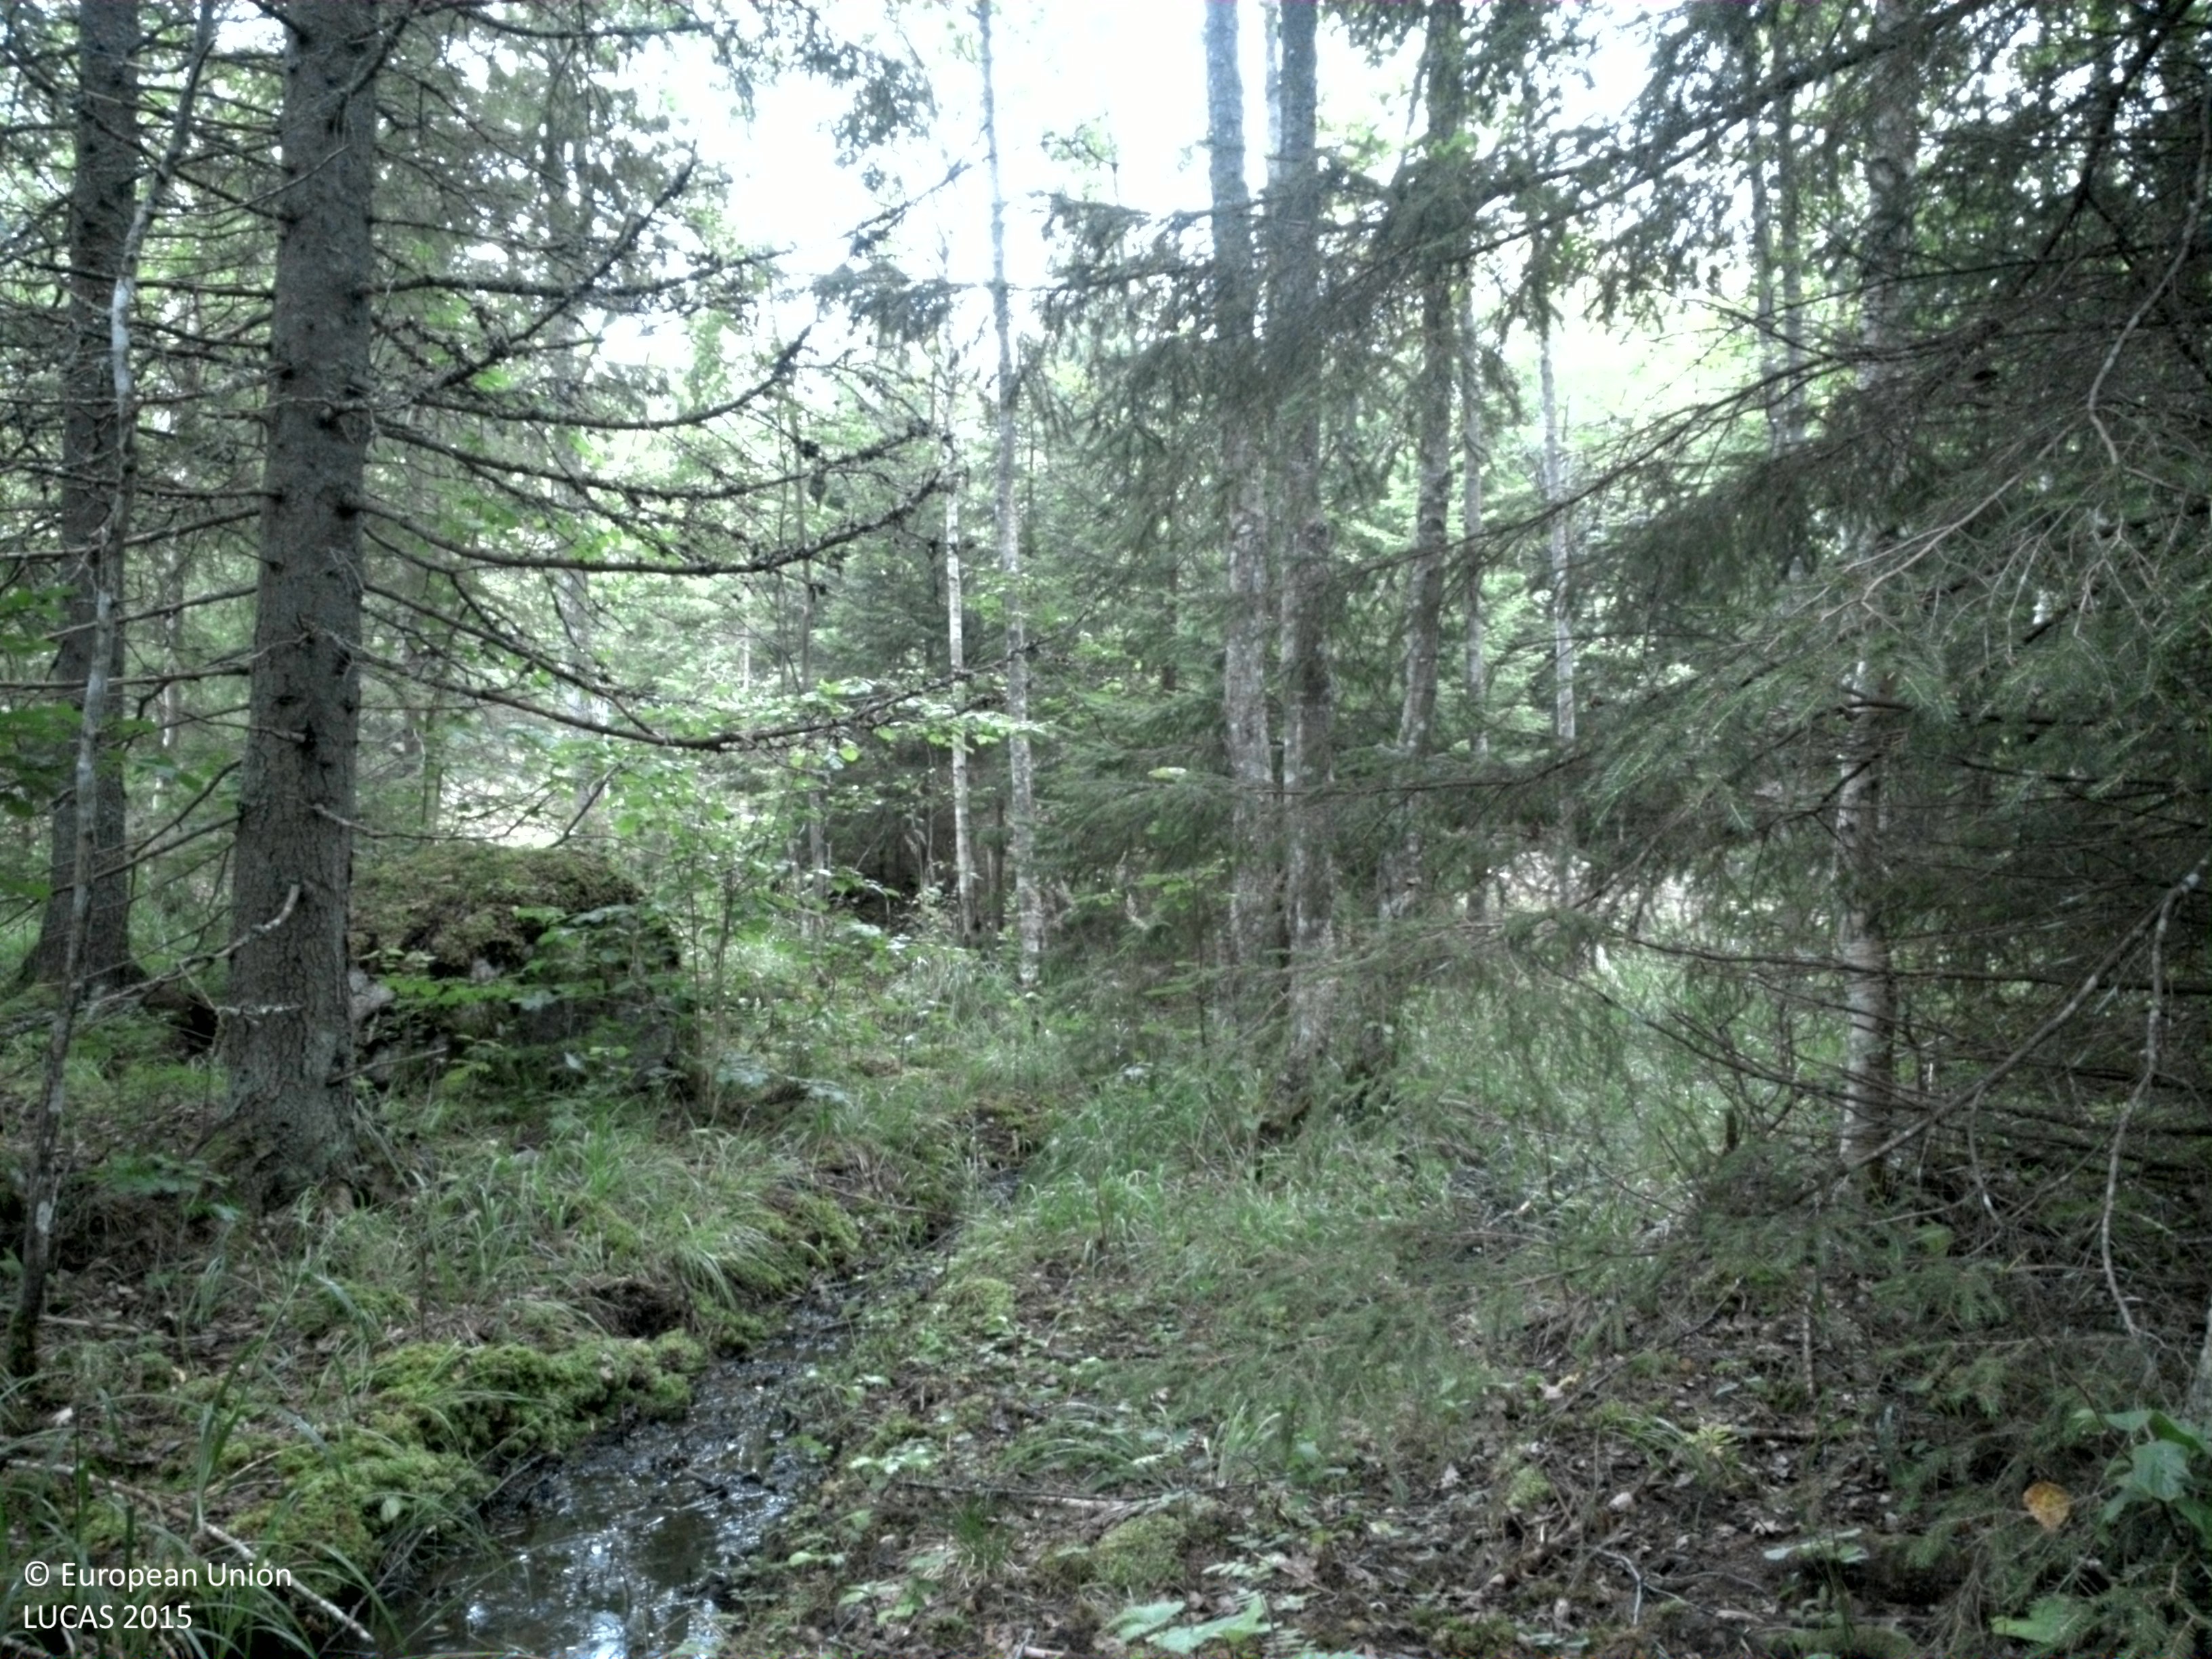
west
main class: Woodland
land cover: Spruce dominated coniferous woodland
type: boreal forest
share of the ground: > 75 %
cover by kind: coniferous forest trees 60 %, herbaceous plants 25 %, broadleaved forest trees 15 %
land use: Forestry
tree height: > 5 m
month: July
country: SE
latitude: 59.8664
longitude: 18.5527
